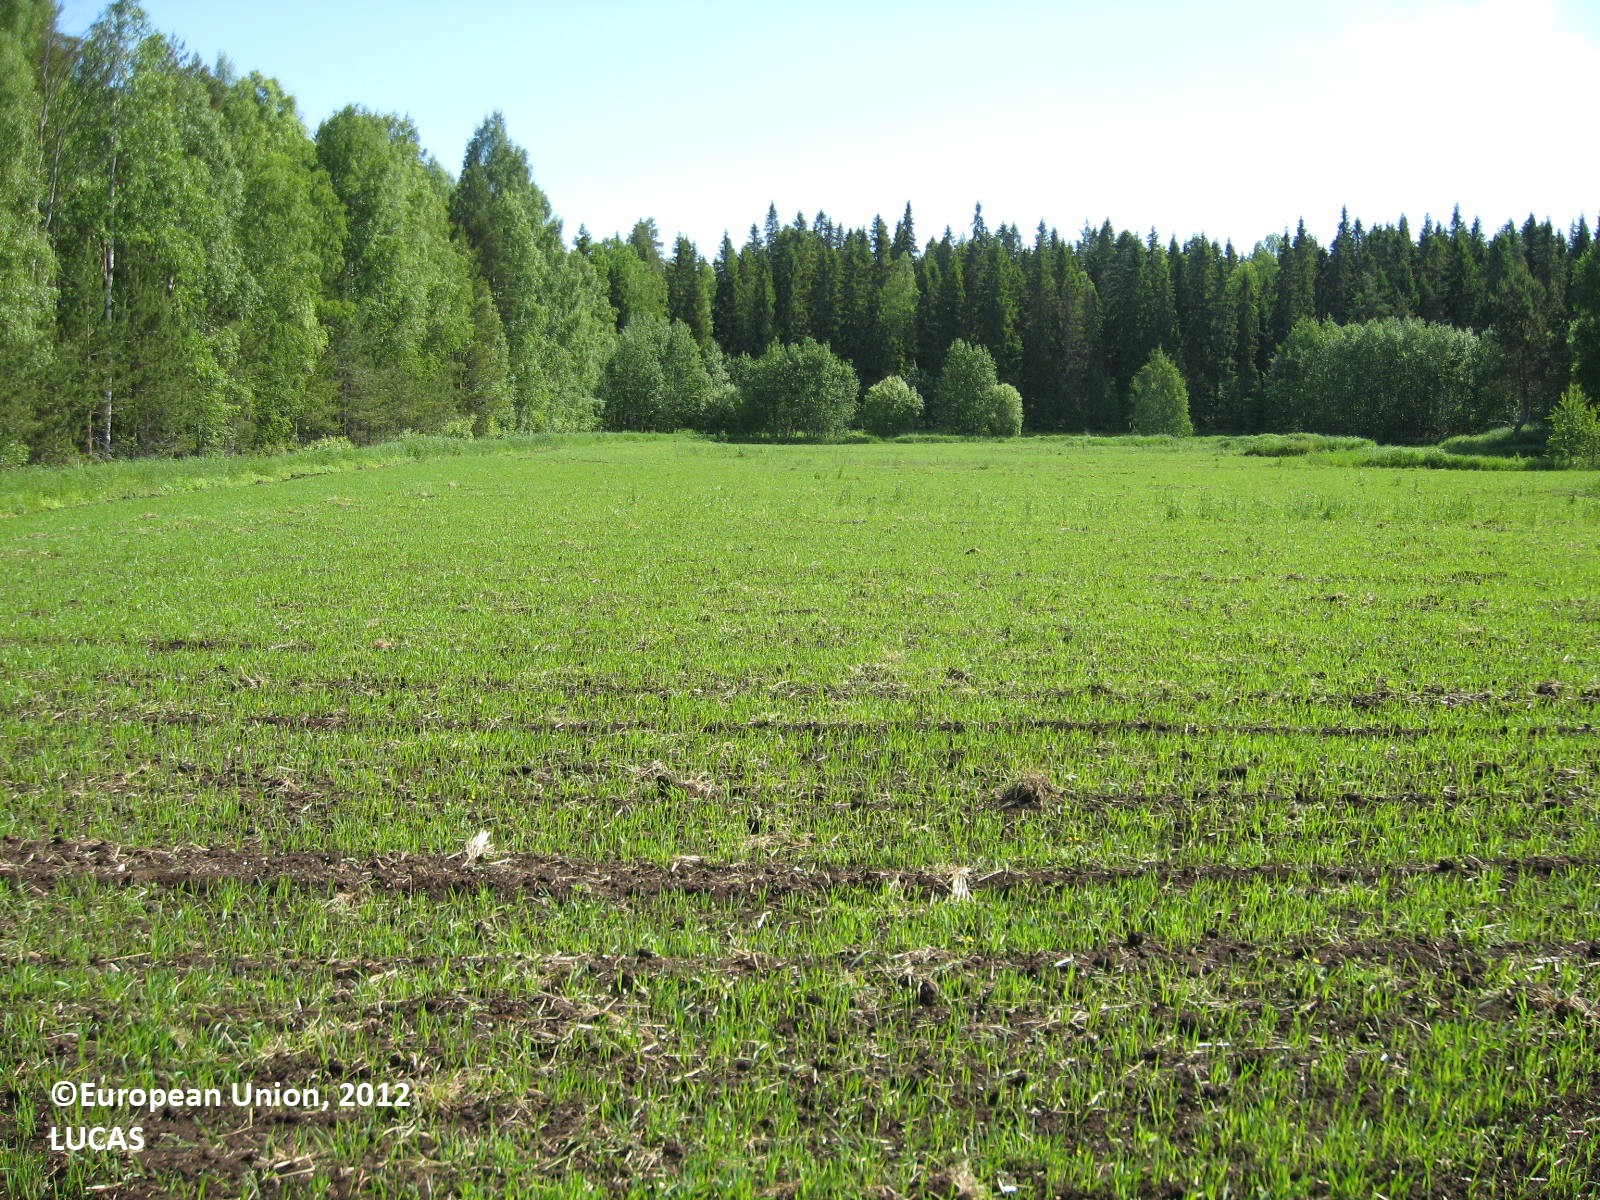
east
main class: Cropland
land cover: Oats
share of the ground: 50 - 75 %
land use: Agriculture (excluding fallow land and kitchen gardens)
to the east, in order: Oats; Grass margins; Lines of trees; Ditches and canals; Grass margins; Oats; Grass margins; Ditches and canals; Spruce dominated coniferous woodland
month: June
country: FI
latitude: 62.8374
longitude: 21.8451
